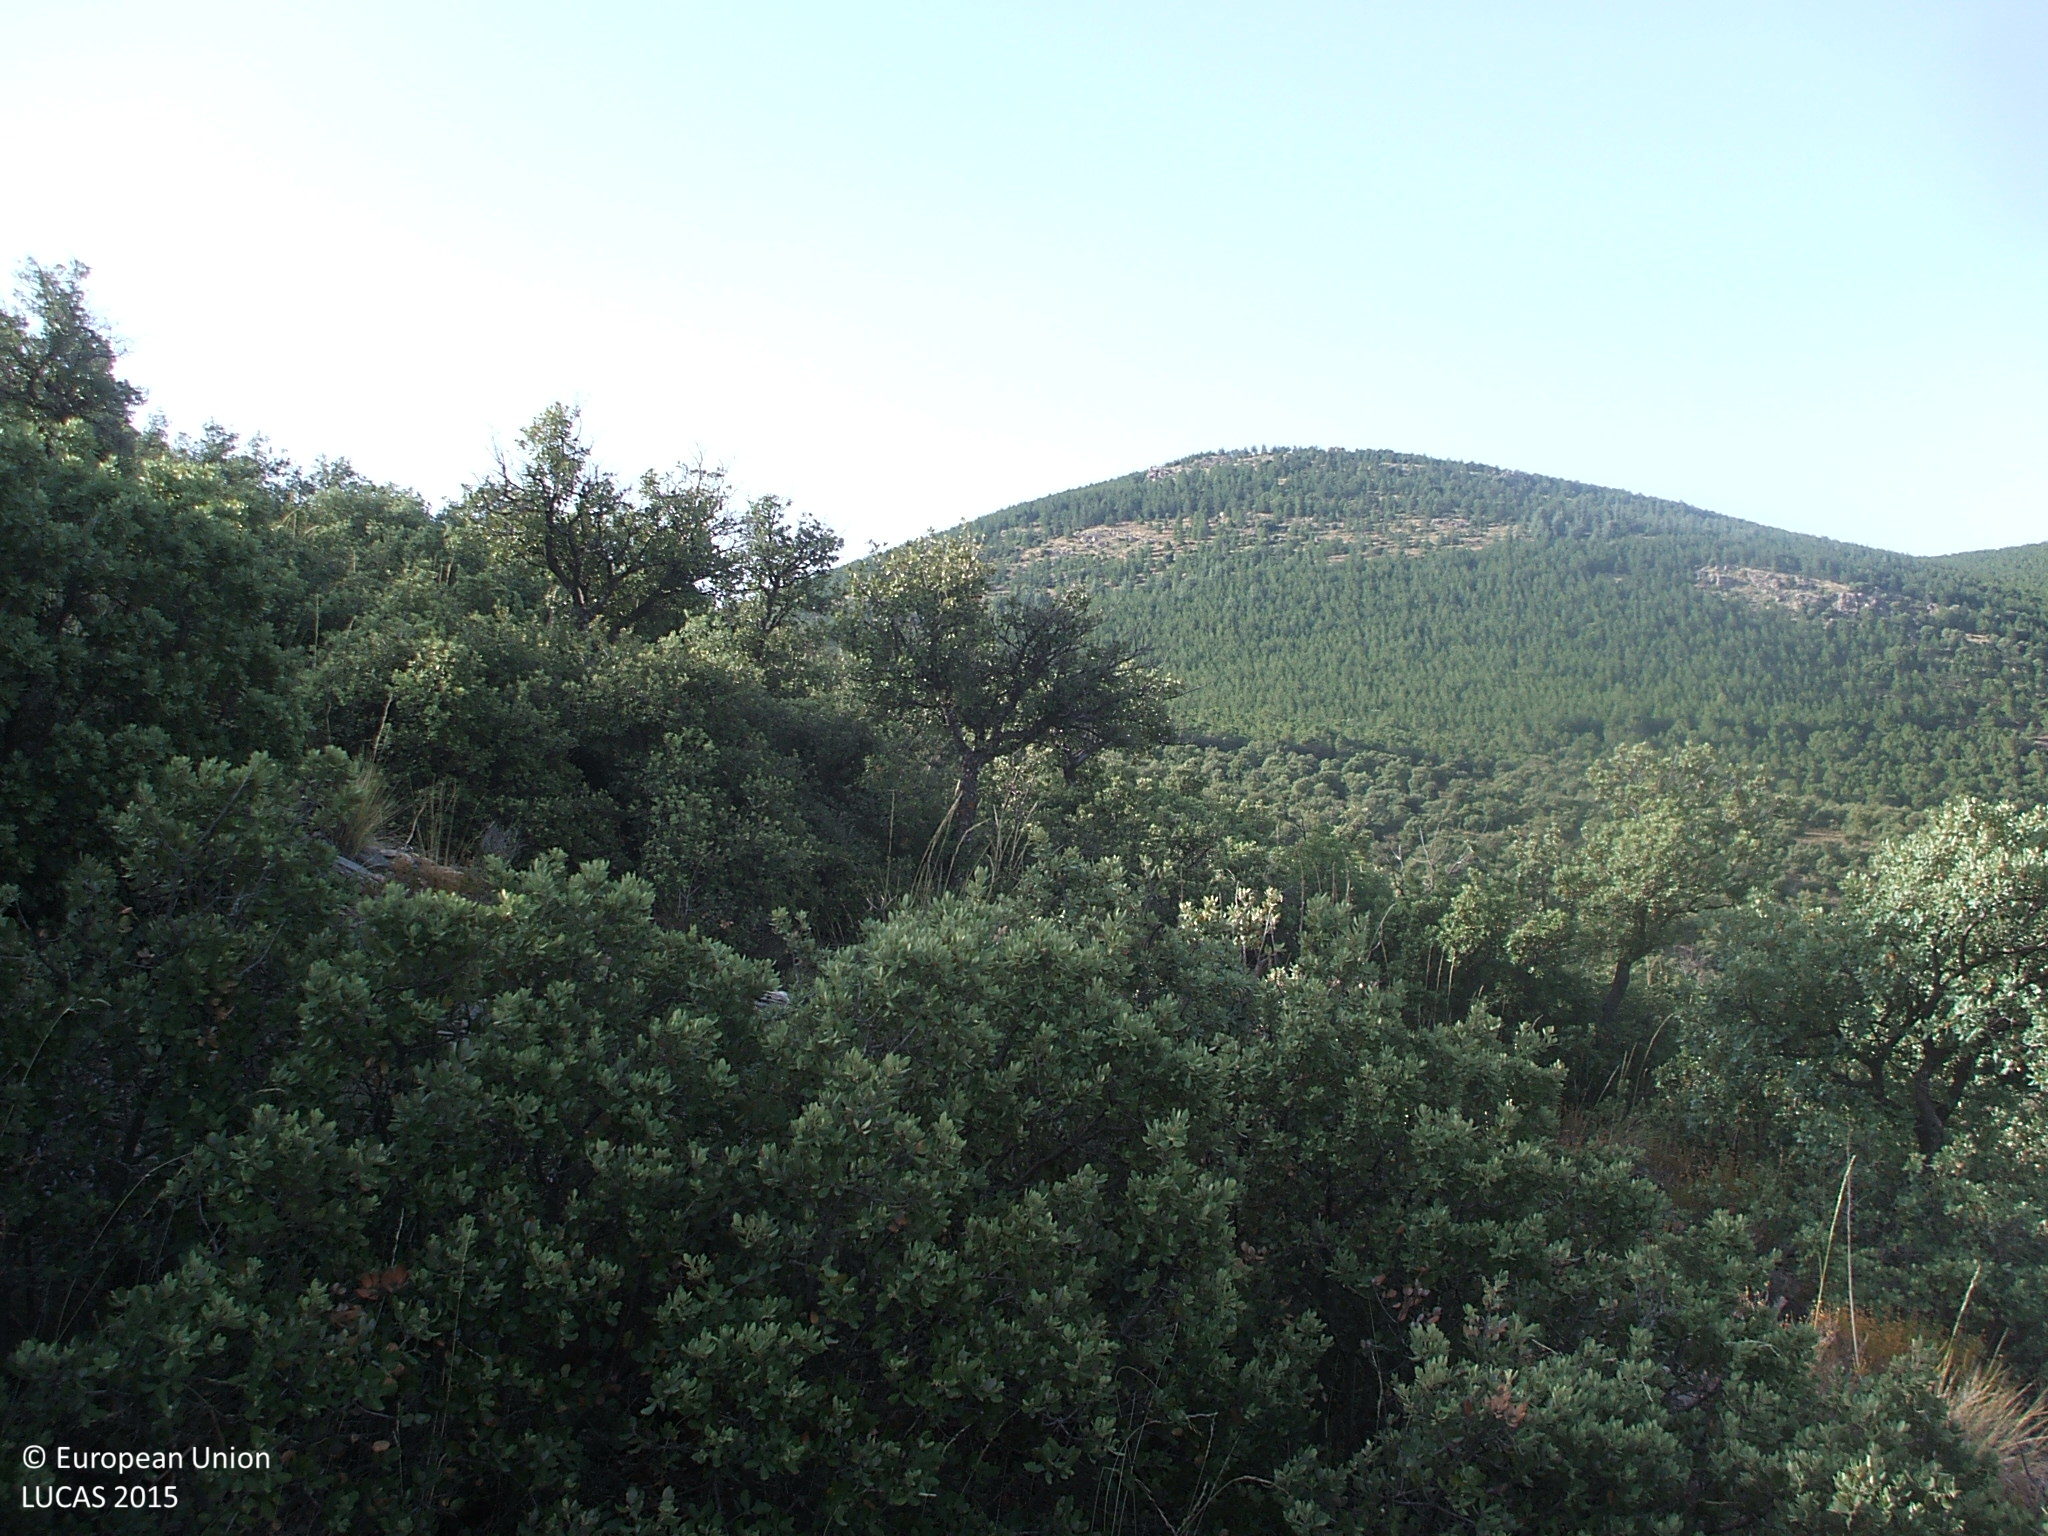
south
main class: Woodland
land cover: Broadleaved woodland
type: broadleaved evergreen forest
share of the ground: 10 - 25 %
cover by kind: shrubs 80 %, broadleaved forest trees 20 %
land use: Semi-natural and natural areas not in use
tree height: < 5 m
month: June
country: ES
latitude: 37.1407
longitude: -2.8954
